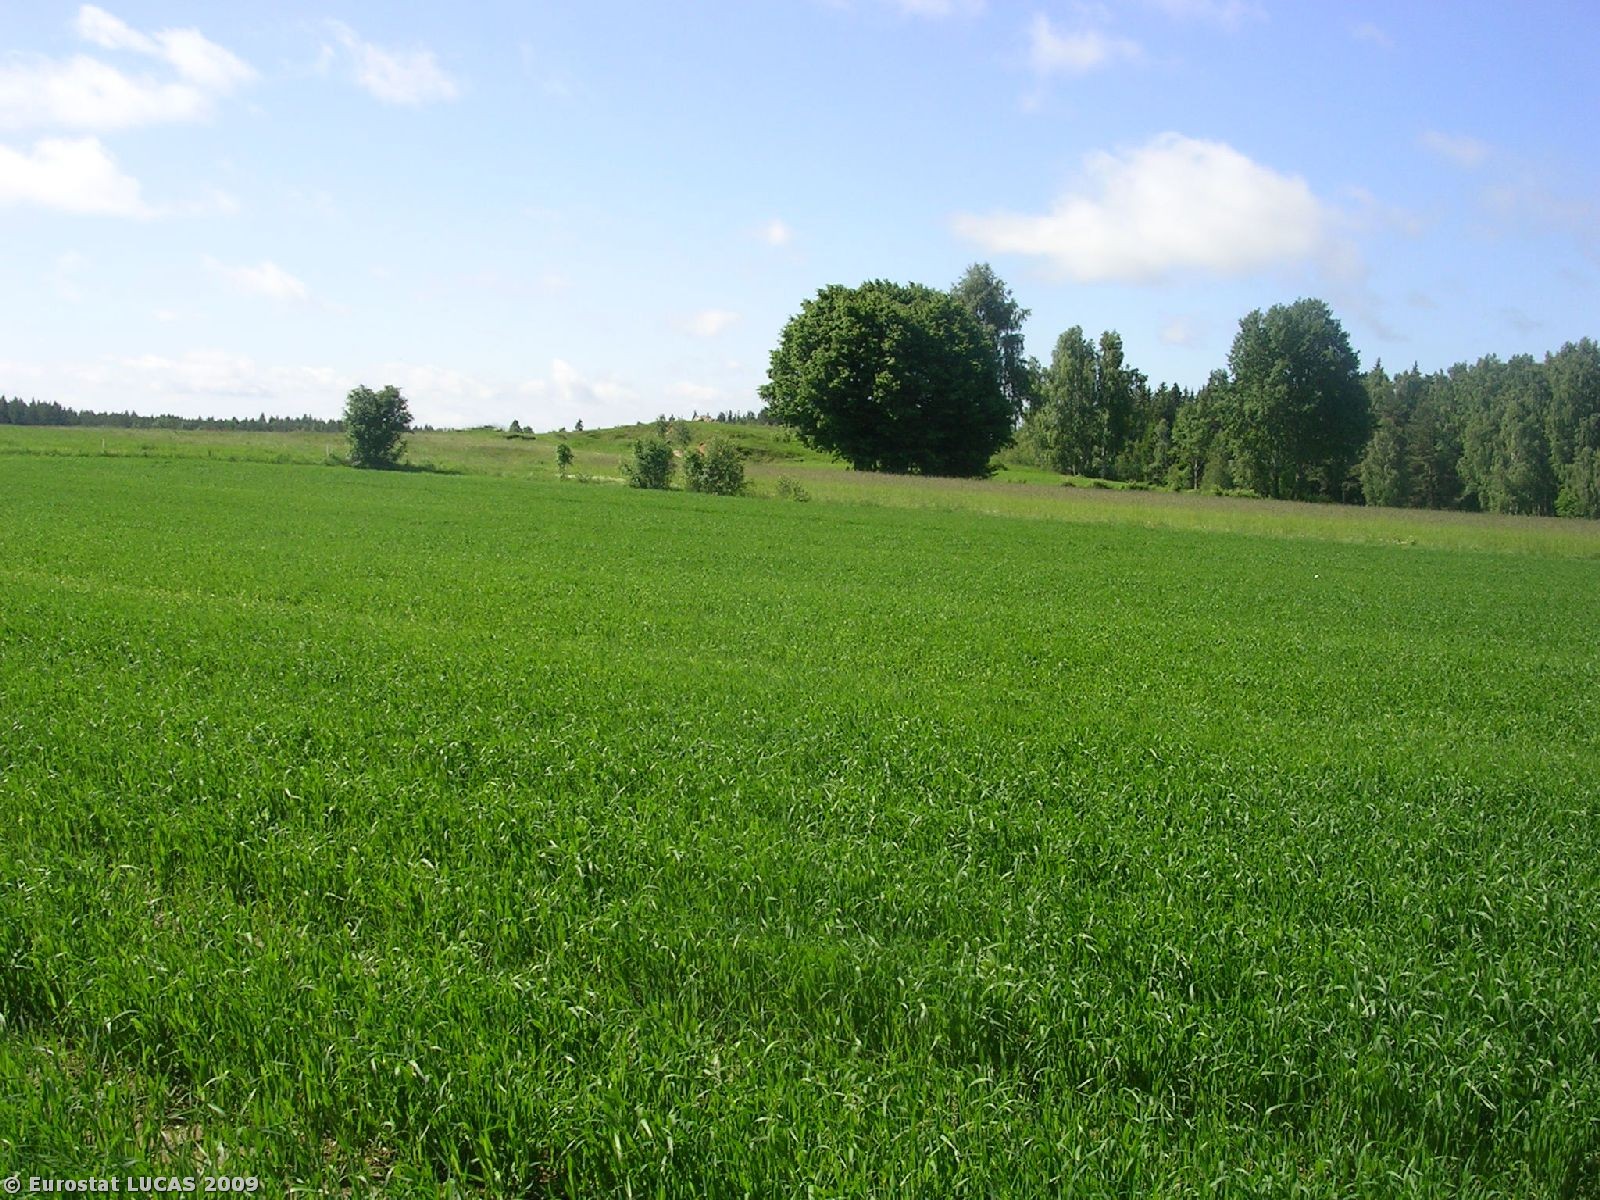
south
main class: Cropland
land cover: Oats
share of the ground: 25 - 50 %
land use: Agriculture (excluding fallow land and kitchen gardens)
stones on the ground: < 10 %
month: August
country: PL
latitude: 53.3856
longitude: 23.6942
